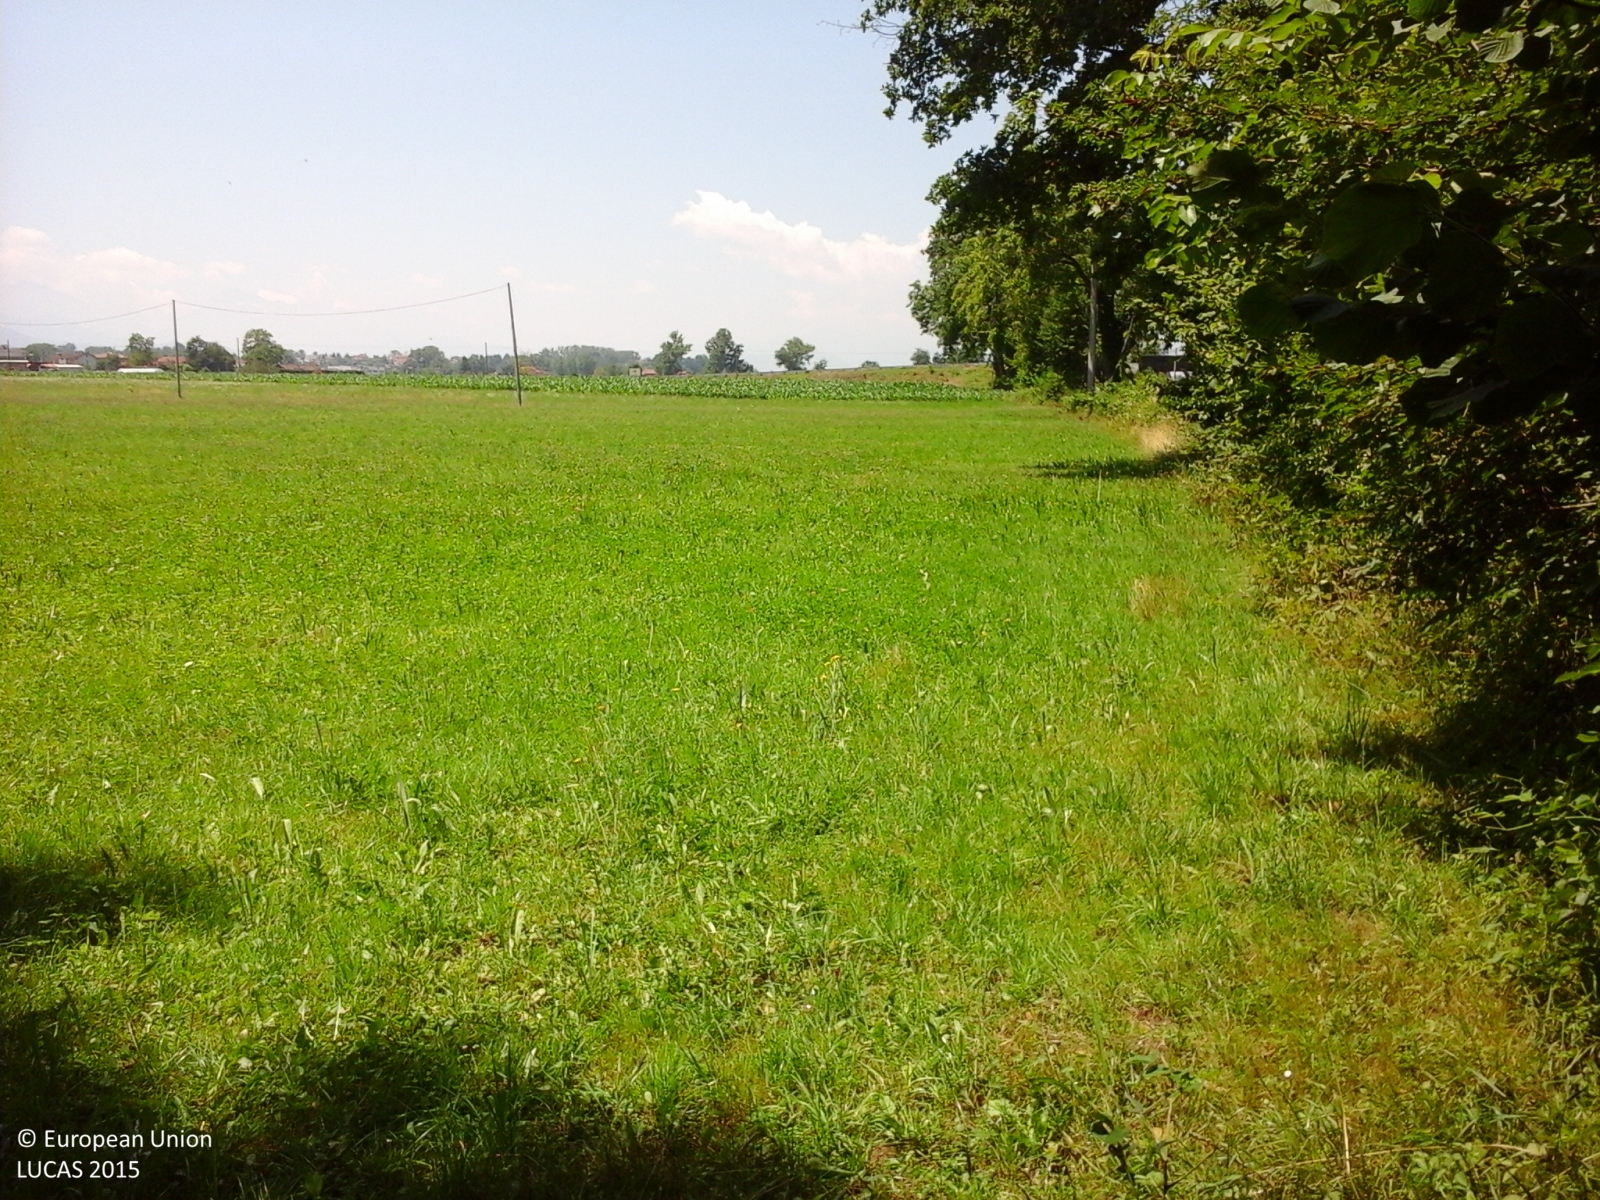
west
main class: Woodland
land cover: Broadleaved woodland
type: thermophilous deciduous forest
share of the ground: > 75 %
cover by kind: broadleaved forest trees 80 %, shrubs 15 %, herbaceous plants 5 %
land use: Semi-natural and natural areas not in use
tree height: > 5 m
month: June
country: IT
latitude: 44.3794
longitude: 7.7080
